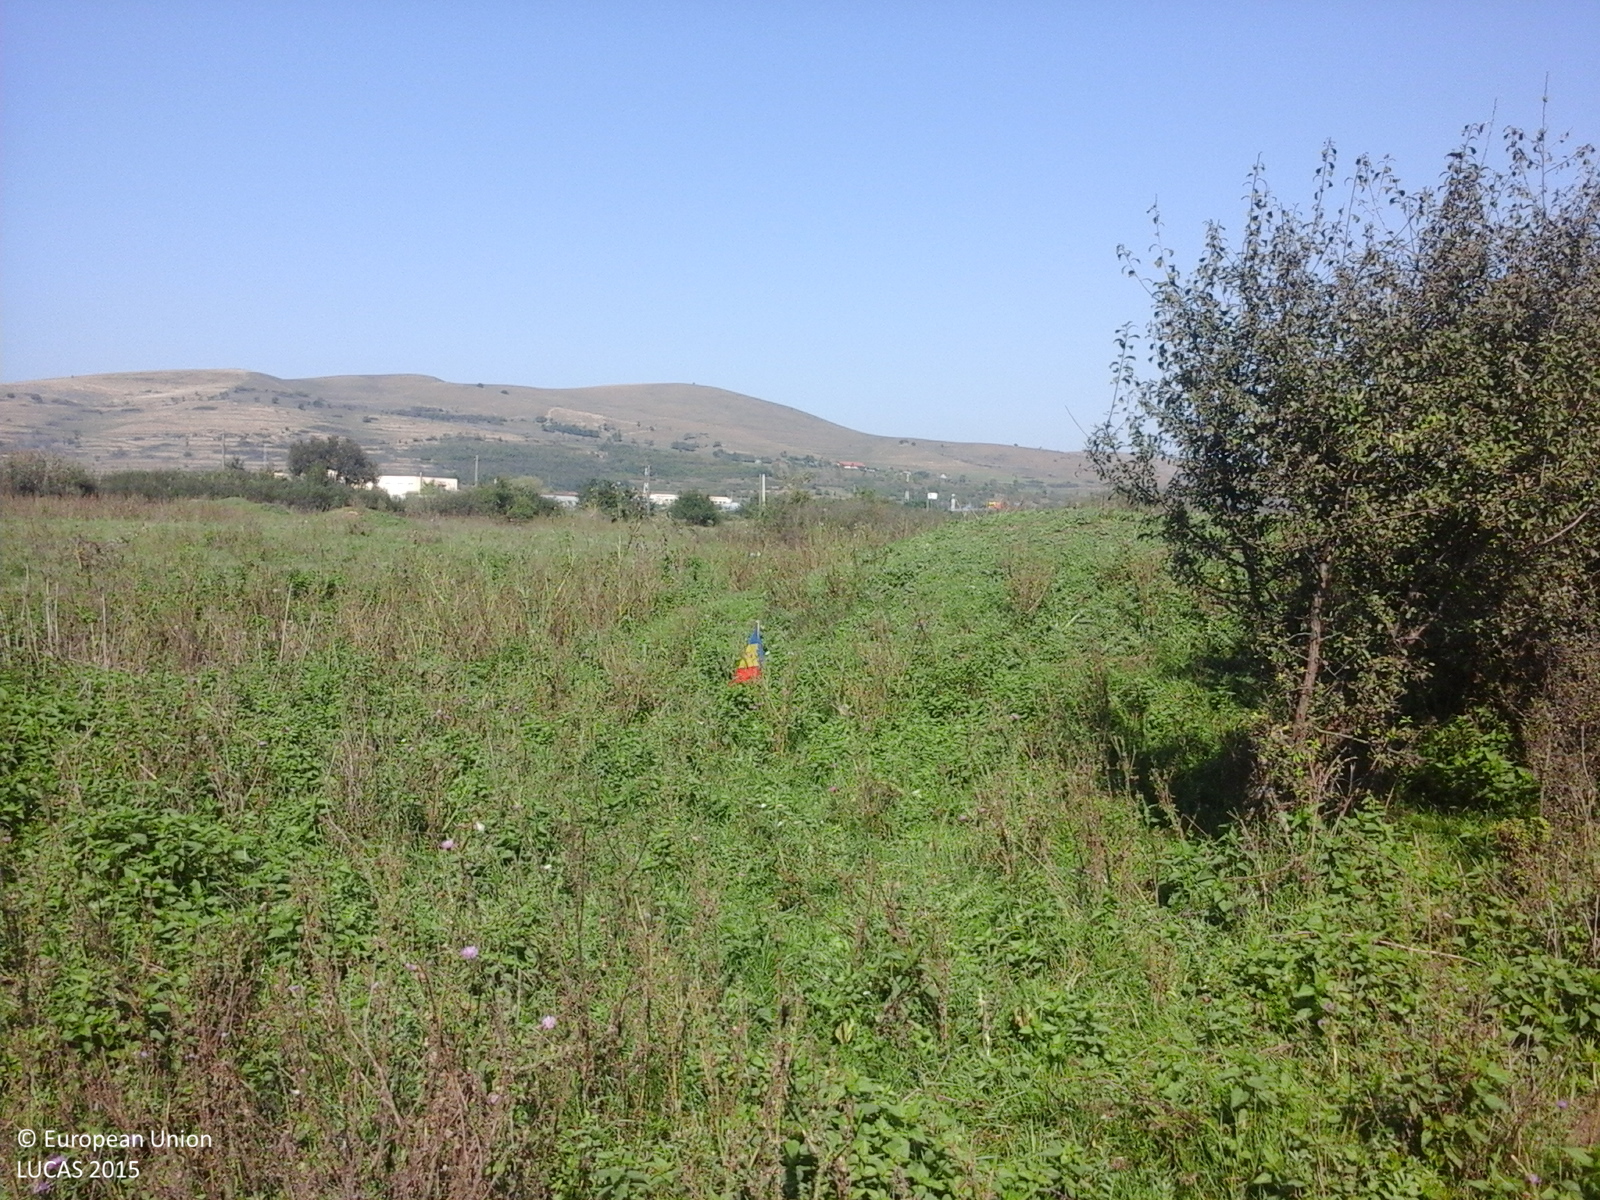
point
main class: Grassland
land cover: Spontaneously vegetated surfaces
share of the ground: > 75 %
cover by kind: herbaceous plants 100 %
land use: Agriculture (excluding fallow land and kitchen gardens)
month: October
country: RO
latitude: 46.0971
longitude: 23.6101
